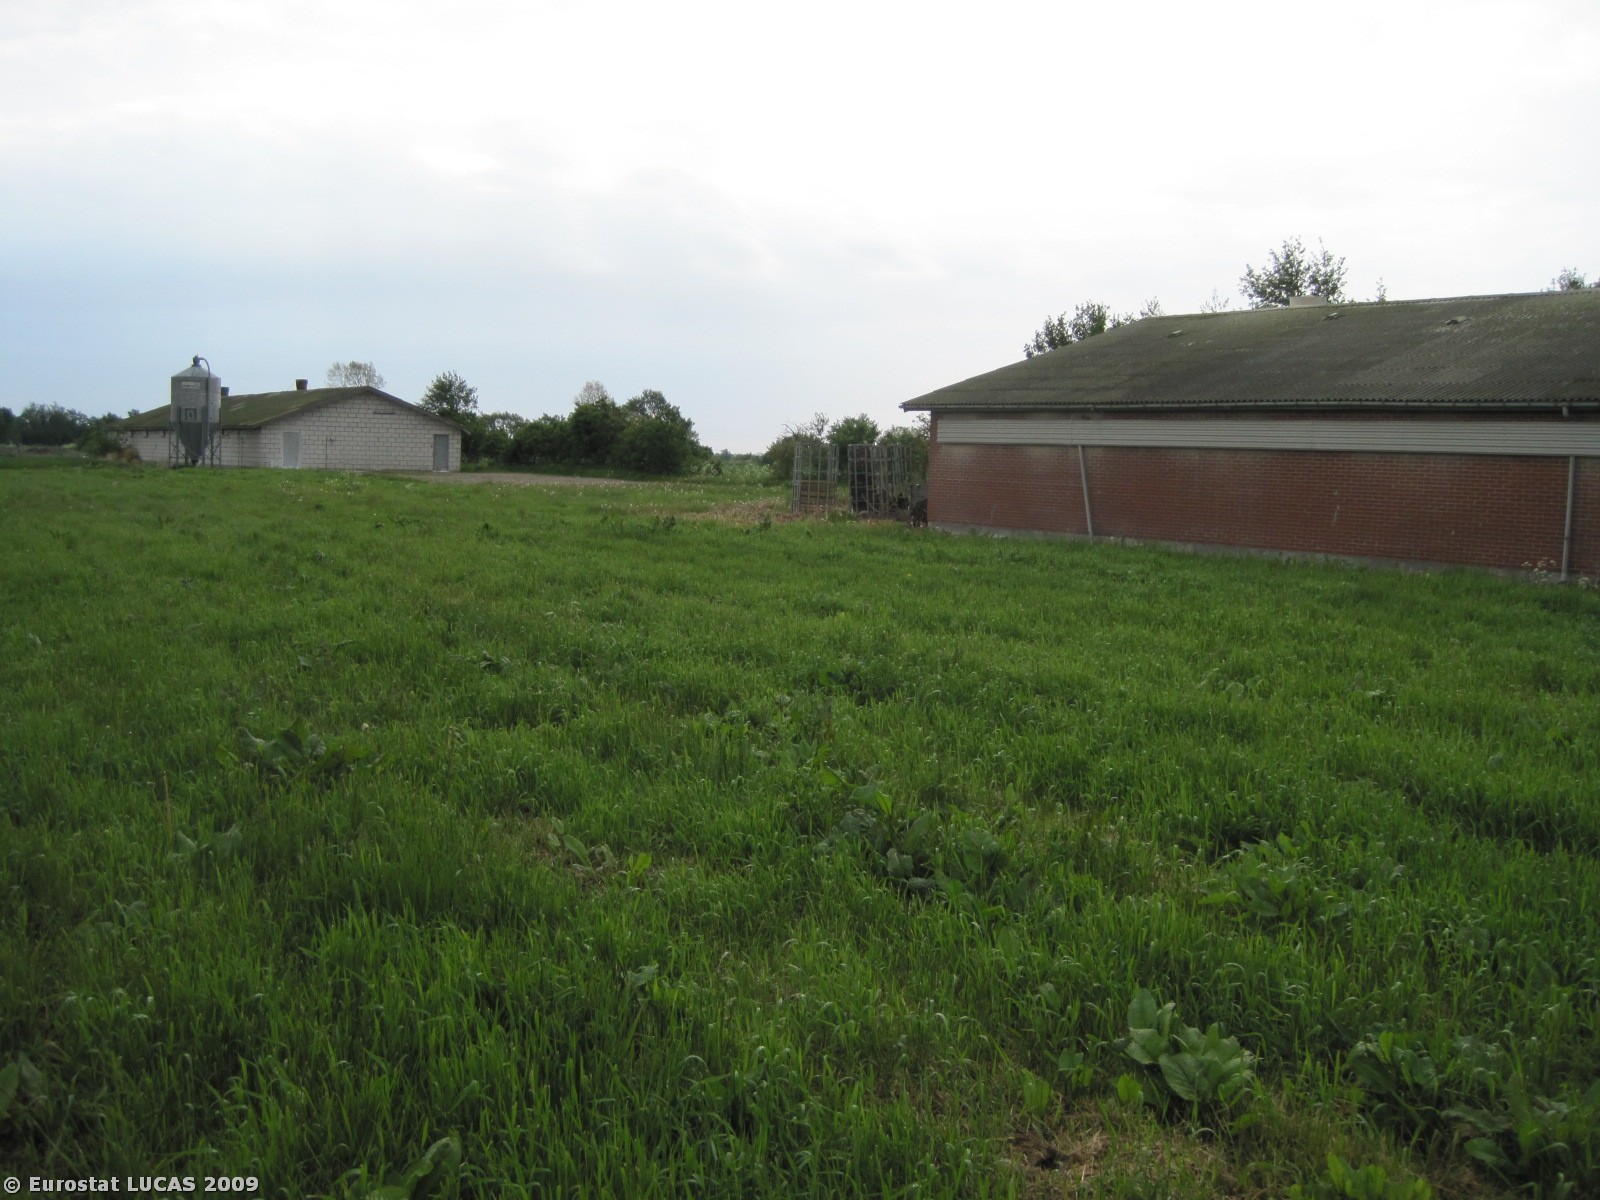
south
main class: Grassland
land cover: Grassland without tree/shrub cover
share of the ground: > 75 %
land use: Agriculture (excluding fallow land and kitchen gardens)
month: May
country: DK
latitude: 56.7808
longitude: 10.2125
